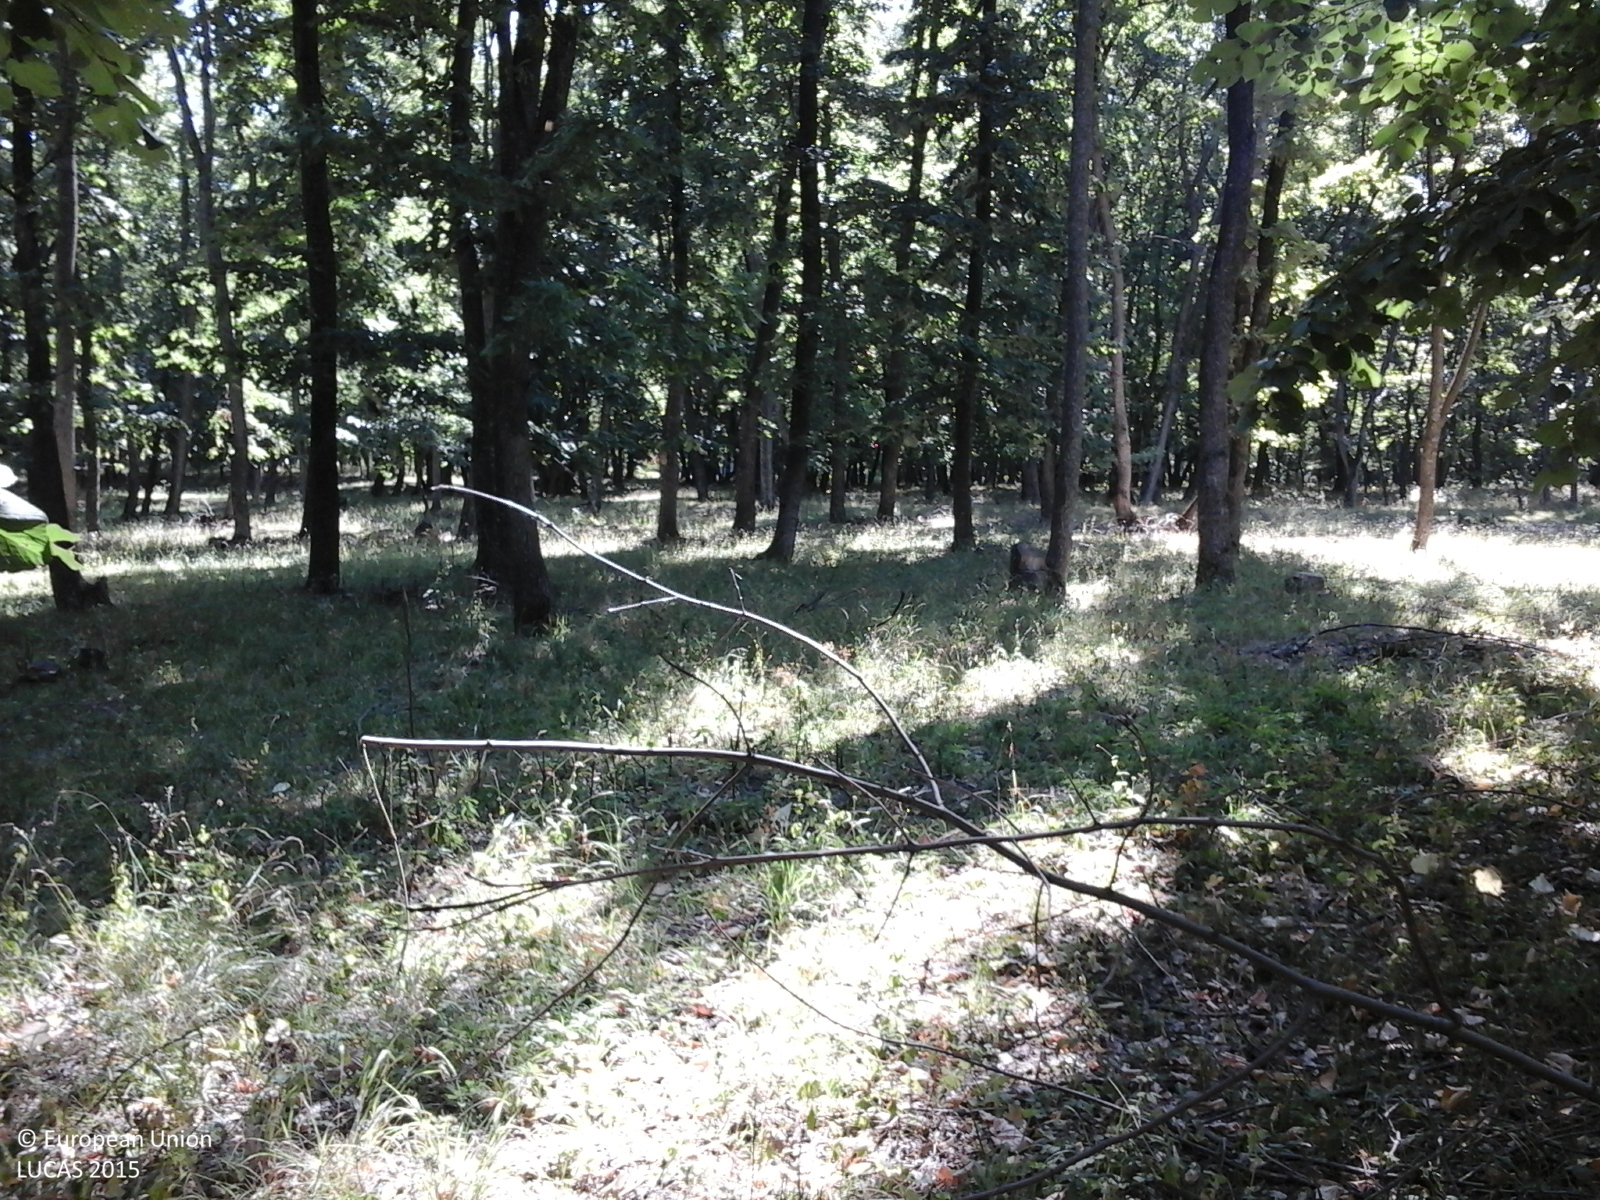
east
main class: Woodland
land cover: Broadleaved woodland
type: mesophytic deciduous forest
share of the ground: > 75 %
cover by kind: broadleaved forest trees 100 %
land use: Forestry
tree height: > 5 m
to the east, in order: Broadleaved woodland; Tracks; Maize
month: July
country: RO
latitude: 45.9999
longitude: 27.7128
